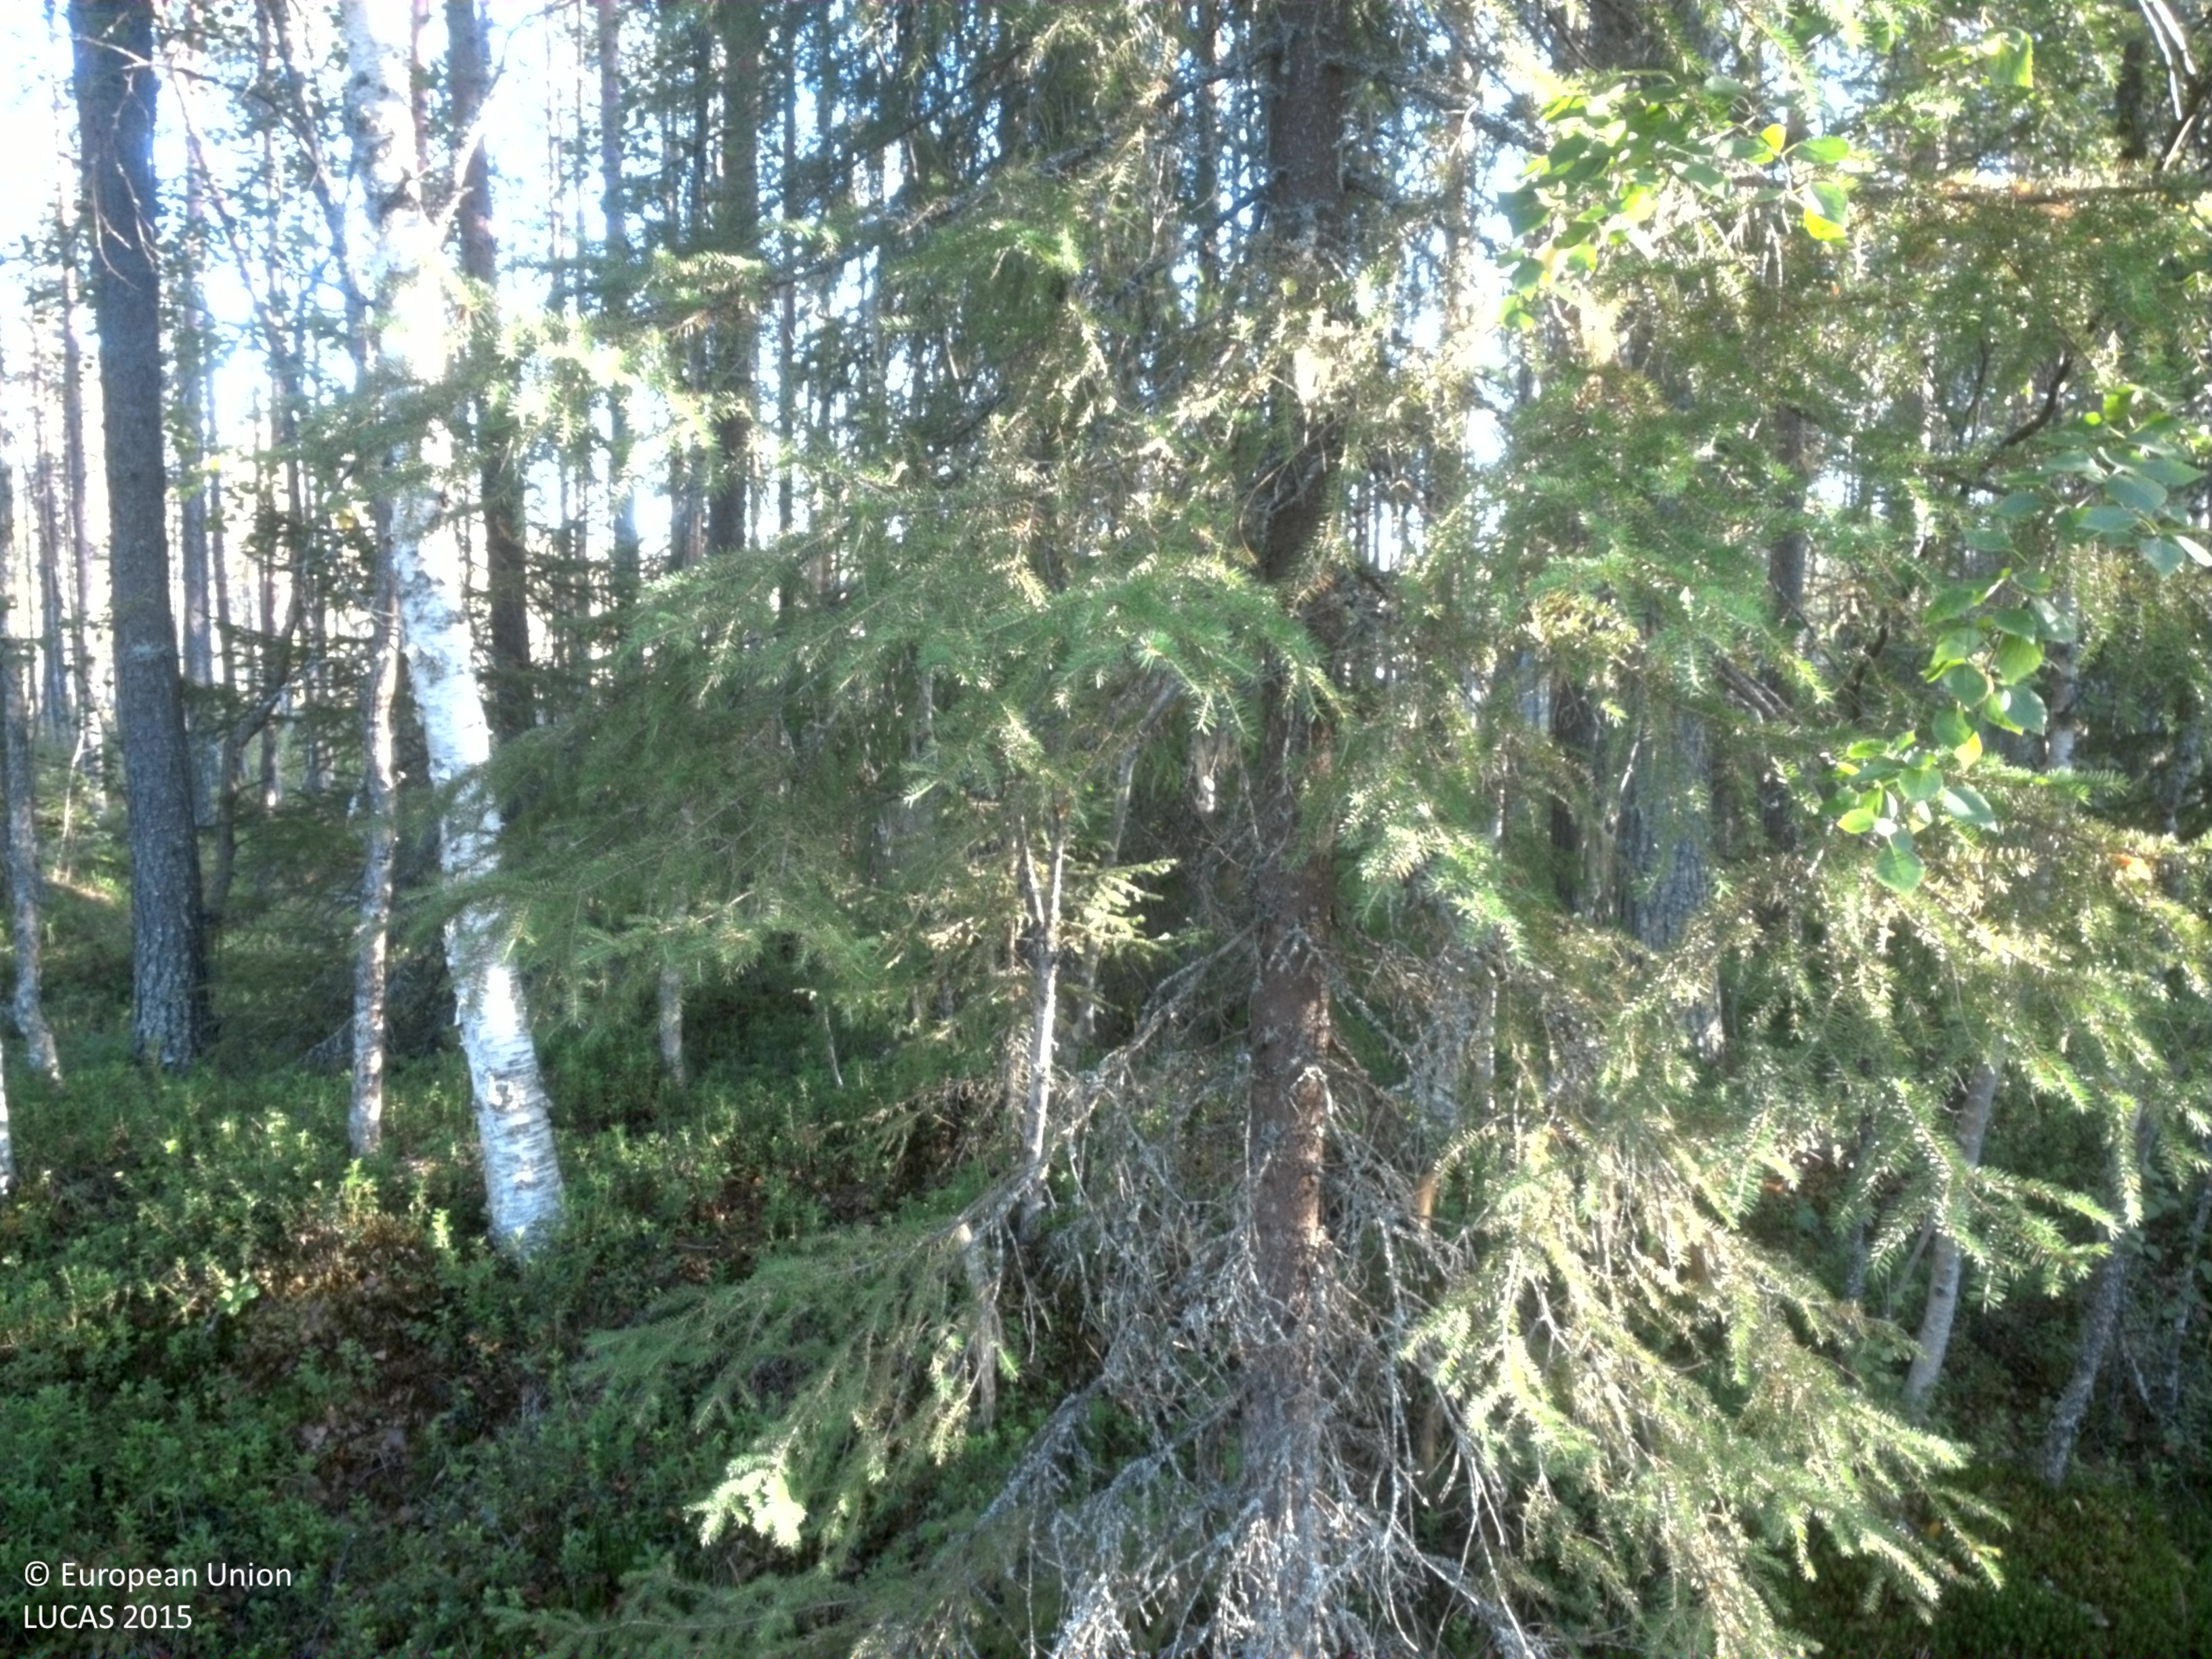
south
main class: Woodland
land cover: Pine dominated mixed woodland
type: boreal forest
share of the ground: 50 - 75 %
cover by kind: coniferous forest trees 45 %, shrubs 35 %, broadleaved forest trees 15 %, lichens and mosses 5 %
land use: Forestry
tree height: > 5 m
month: August
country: SE
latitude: 64.6165
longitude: 18.3092
